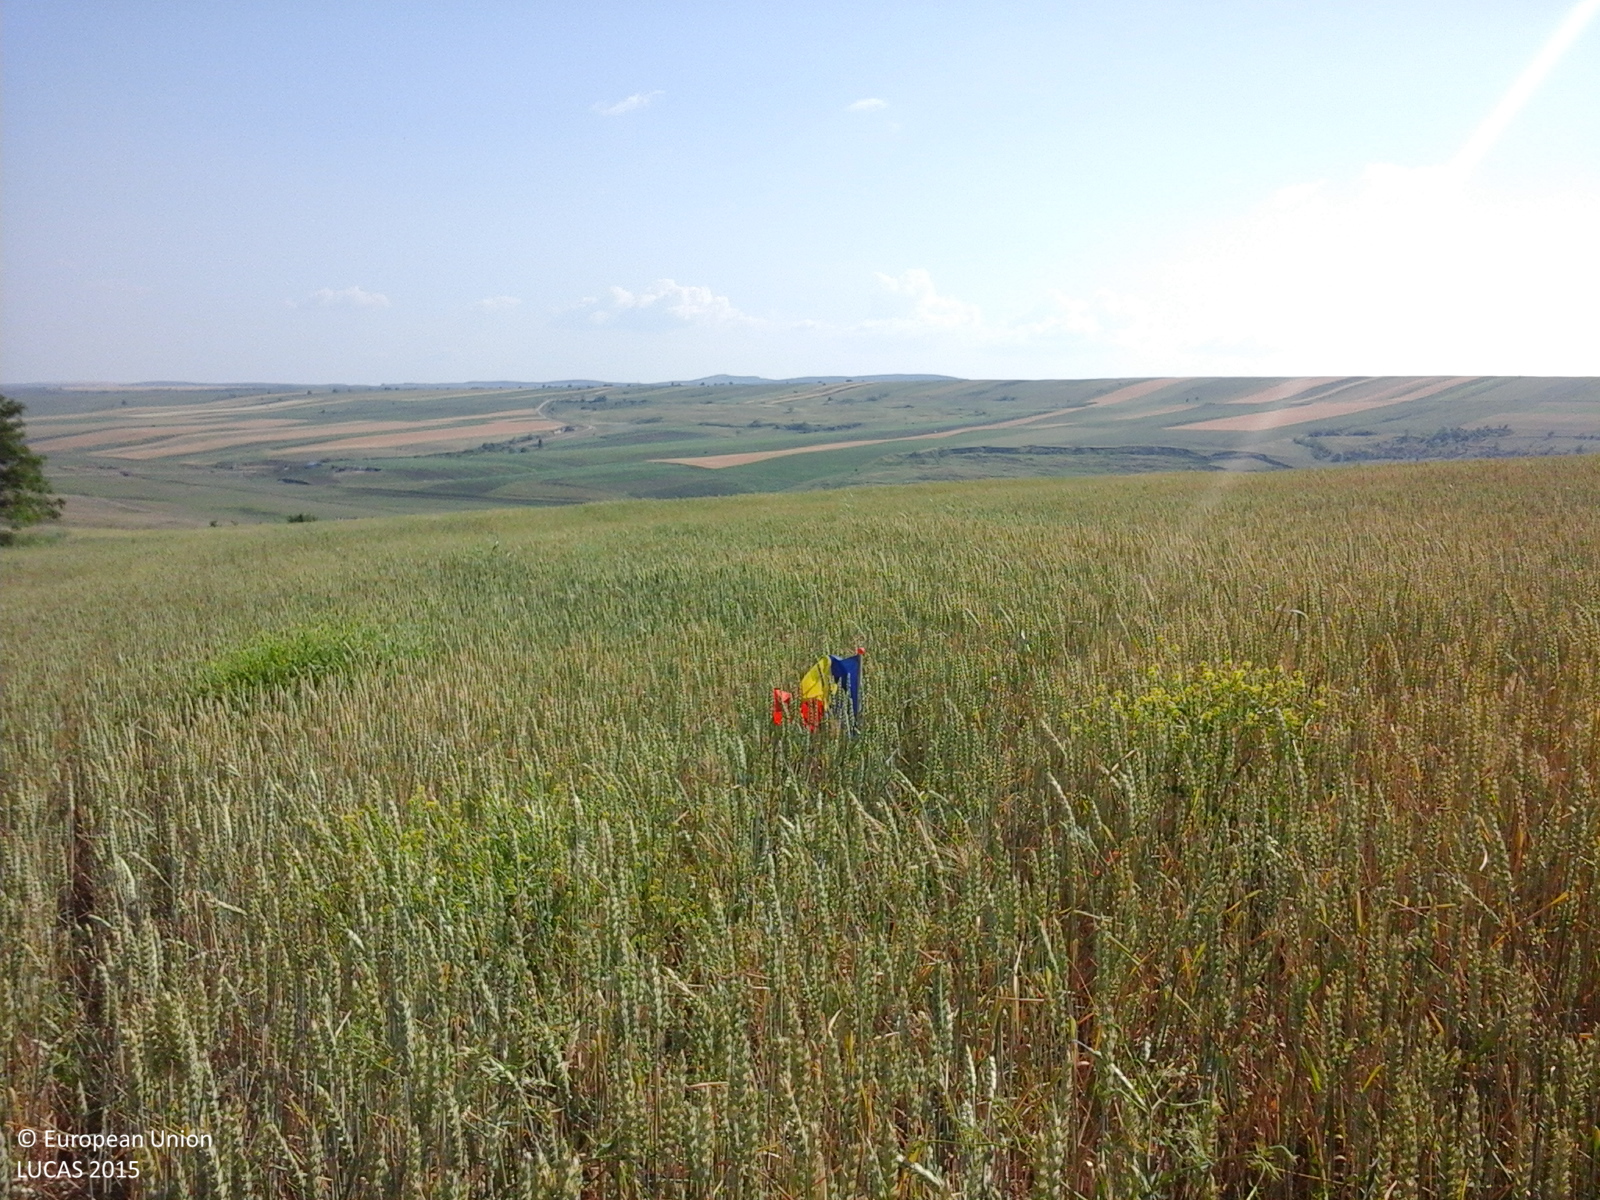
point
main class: Cropland
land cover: Common wheat
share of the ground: > 75 %
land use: Agriculture (excluding fallow land and kitchen gardens)
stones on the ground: < 10 %
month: June
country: RO
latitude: 46.8093
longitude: 27.7195
